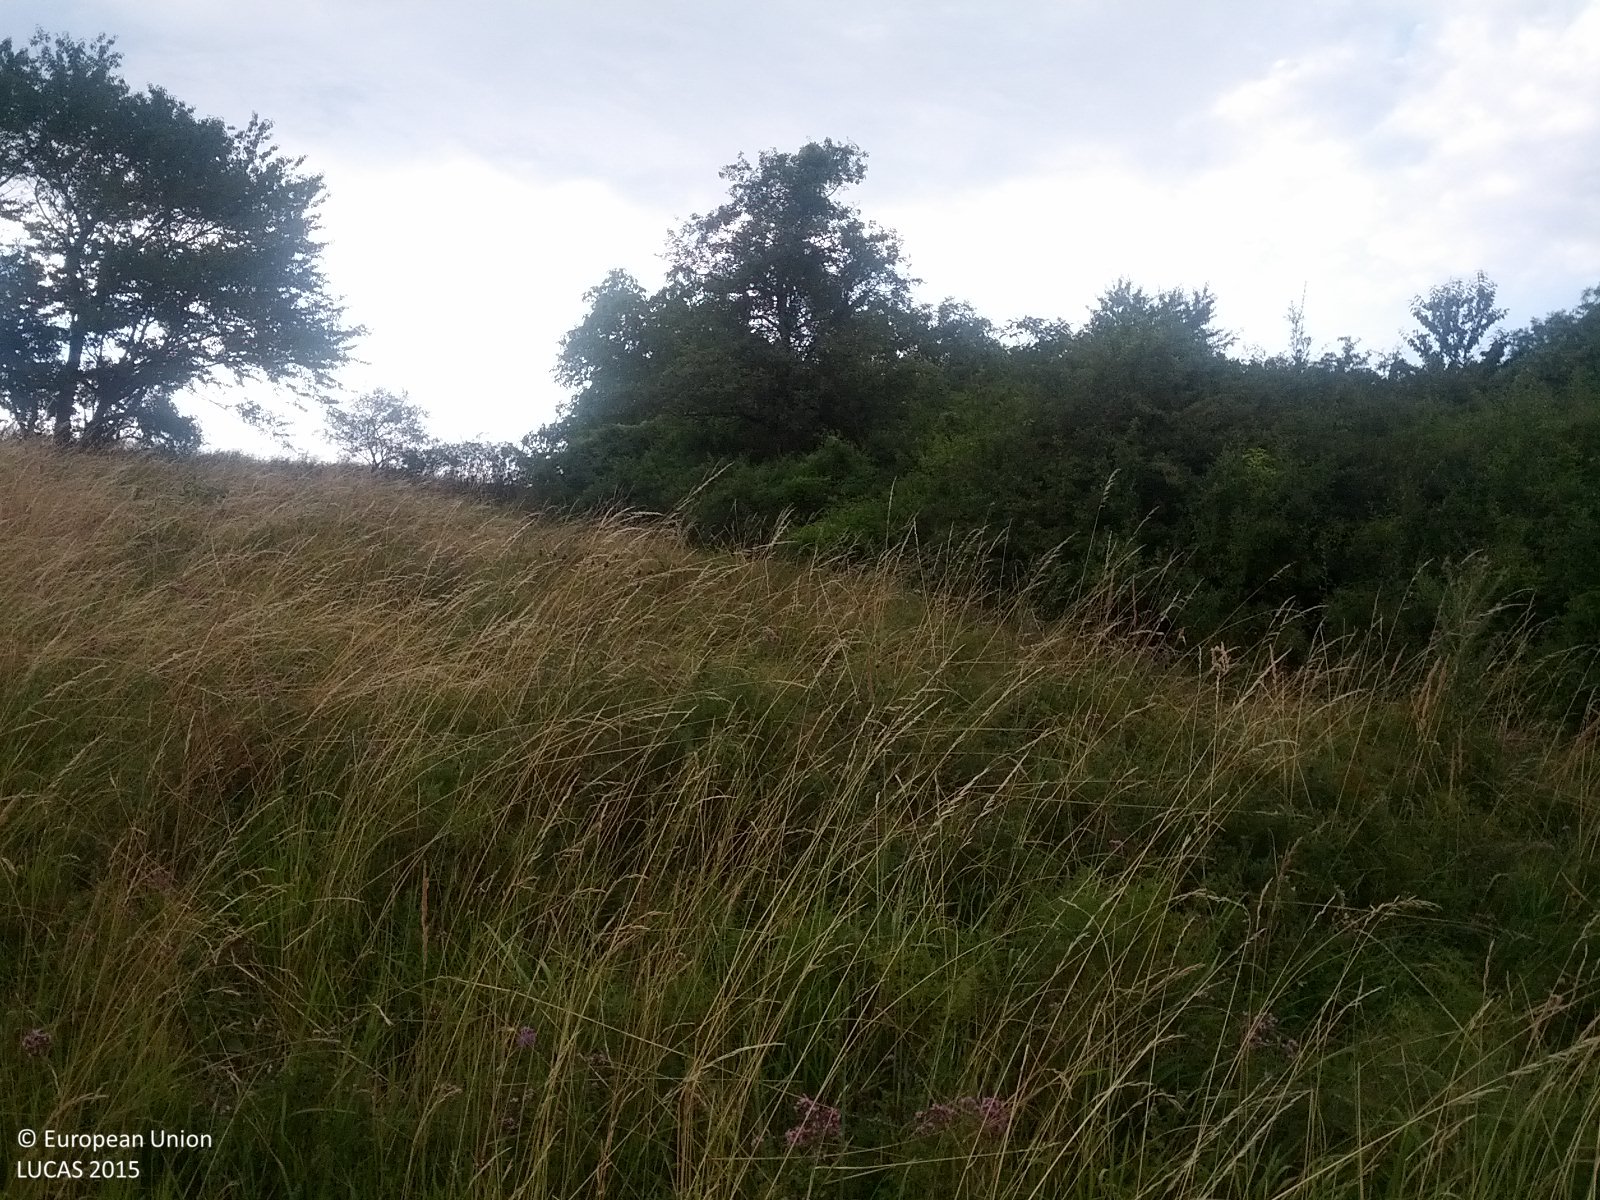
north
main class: Grassland
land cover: Grassland without tree/shrub cover
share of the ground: > 75 %
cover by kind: herbaceous plants 100 %
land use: Agriculture (excluding fallow land and kitchen gardens)
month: July
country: AT
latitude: 48.5141
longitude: 16.2730
